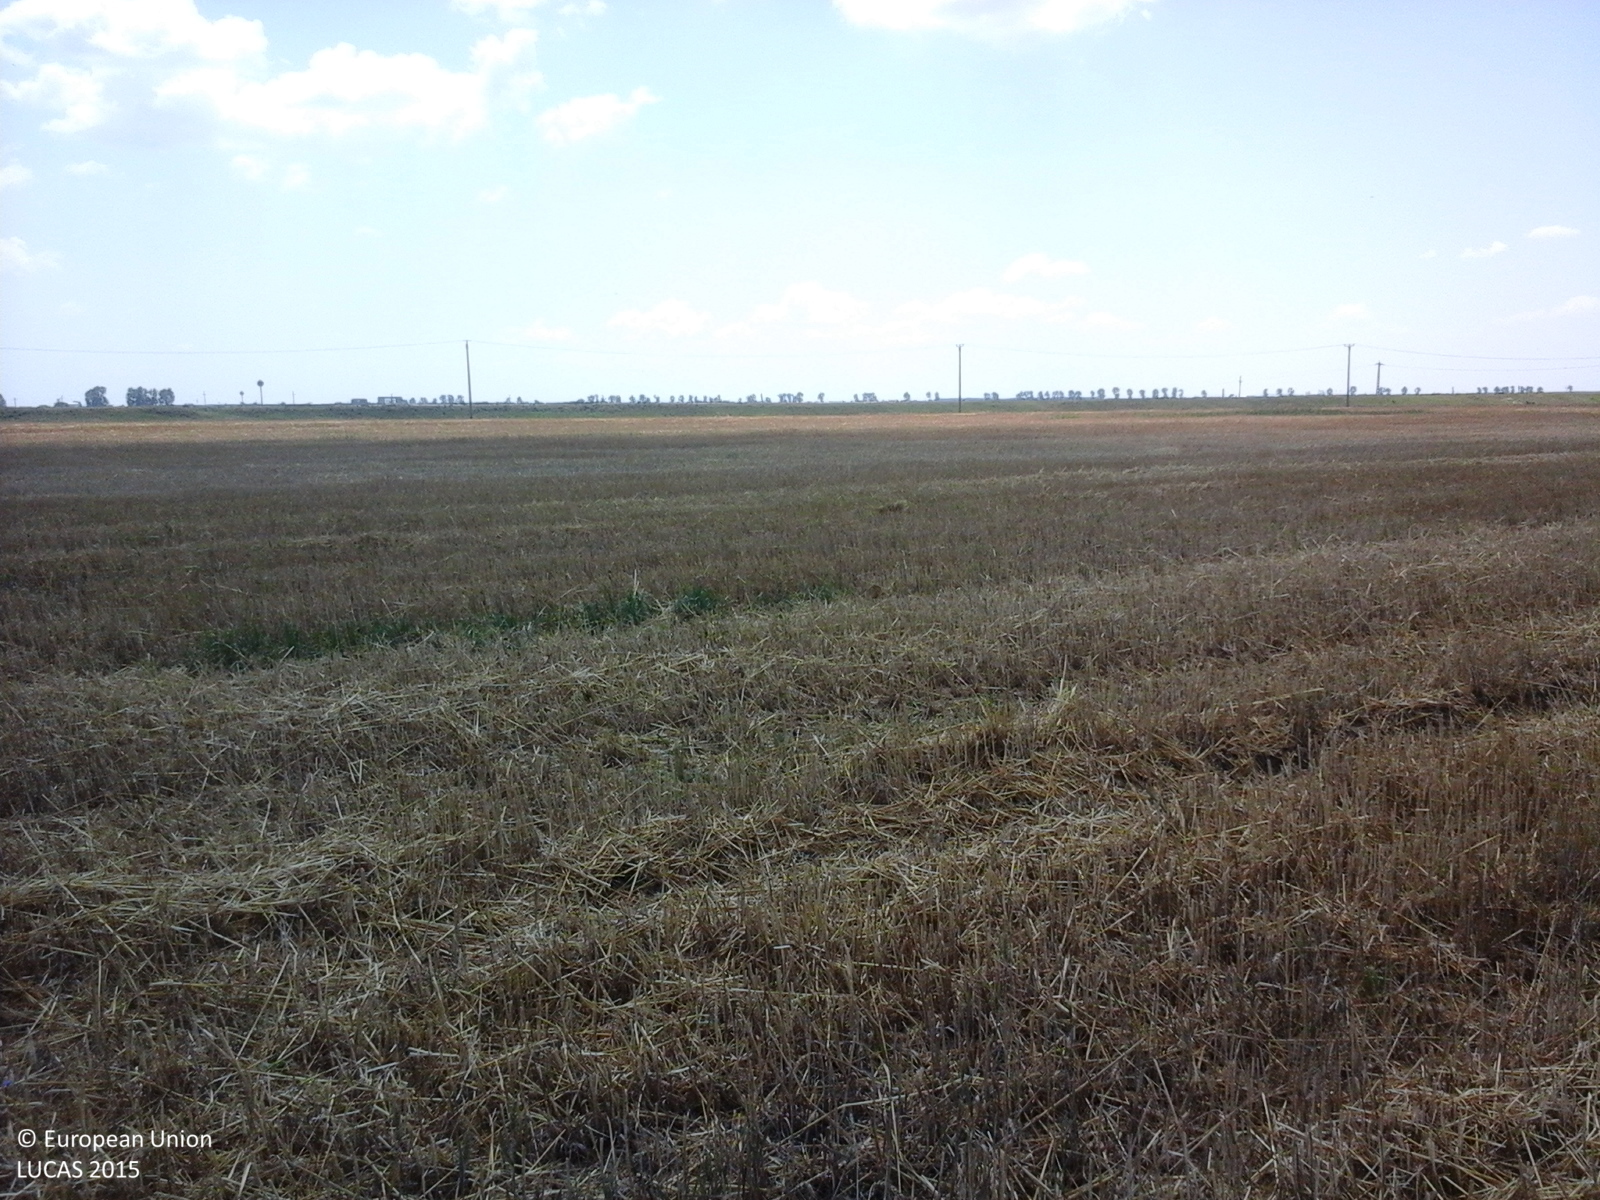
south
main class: Cropland
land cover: Common wheat
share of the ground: 50 - 75 %
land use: Agriculture (excluding fallow land and kitchen gardens)
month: July
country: RO
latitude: 44.2048
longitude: 24.6246
